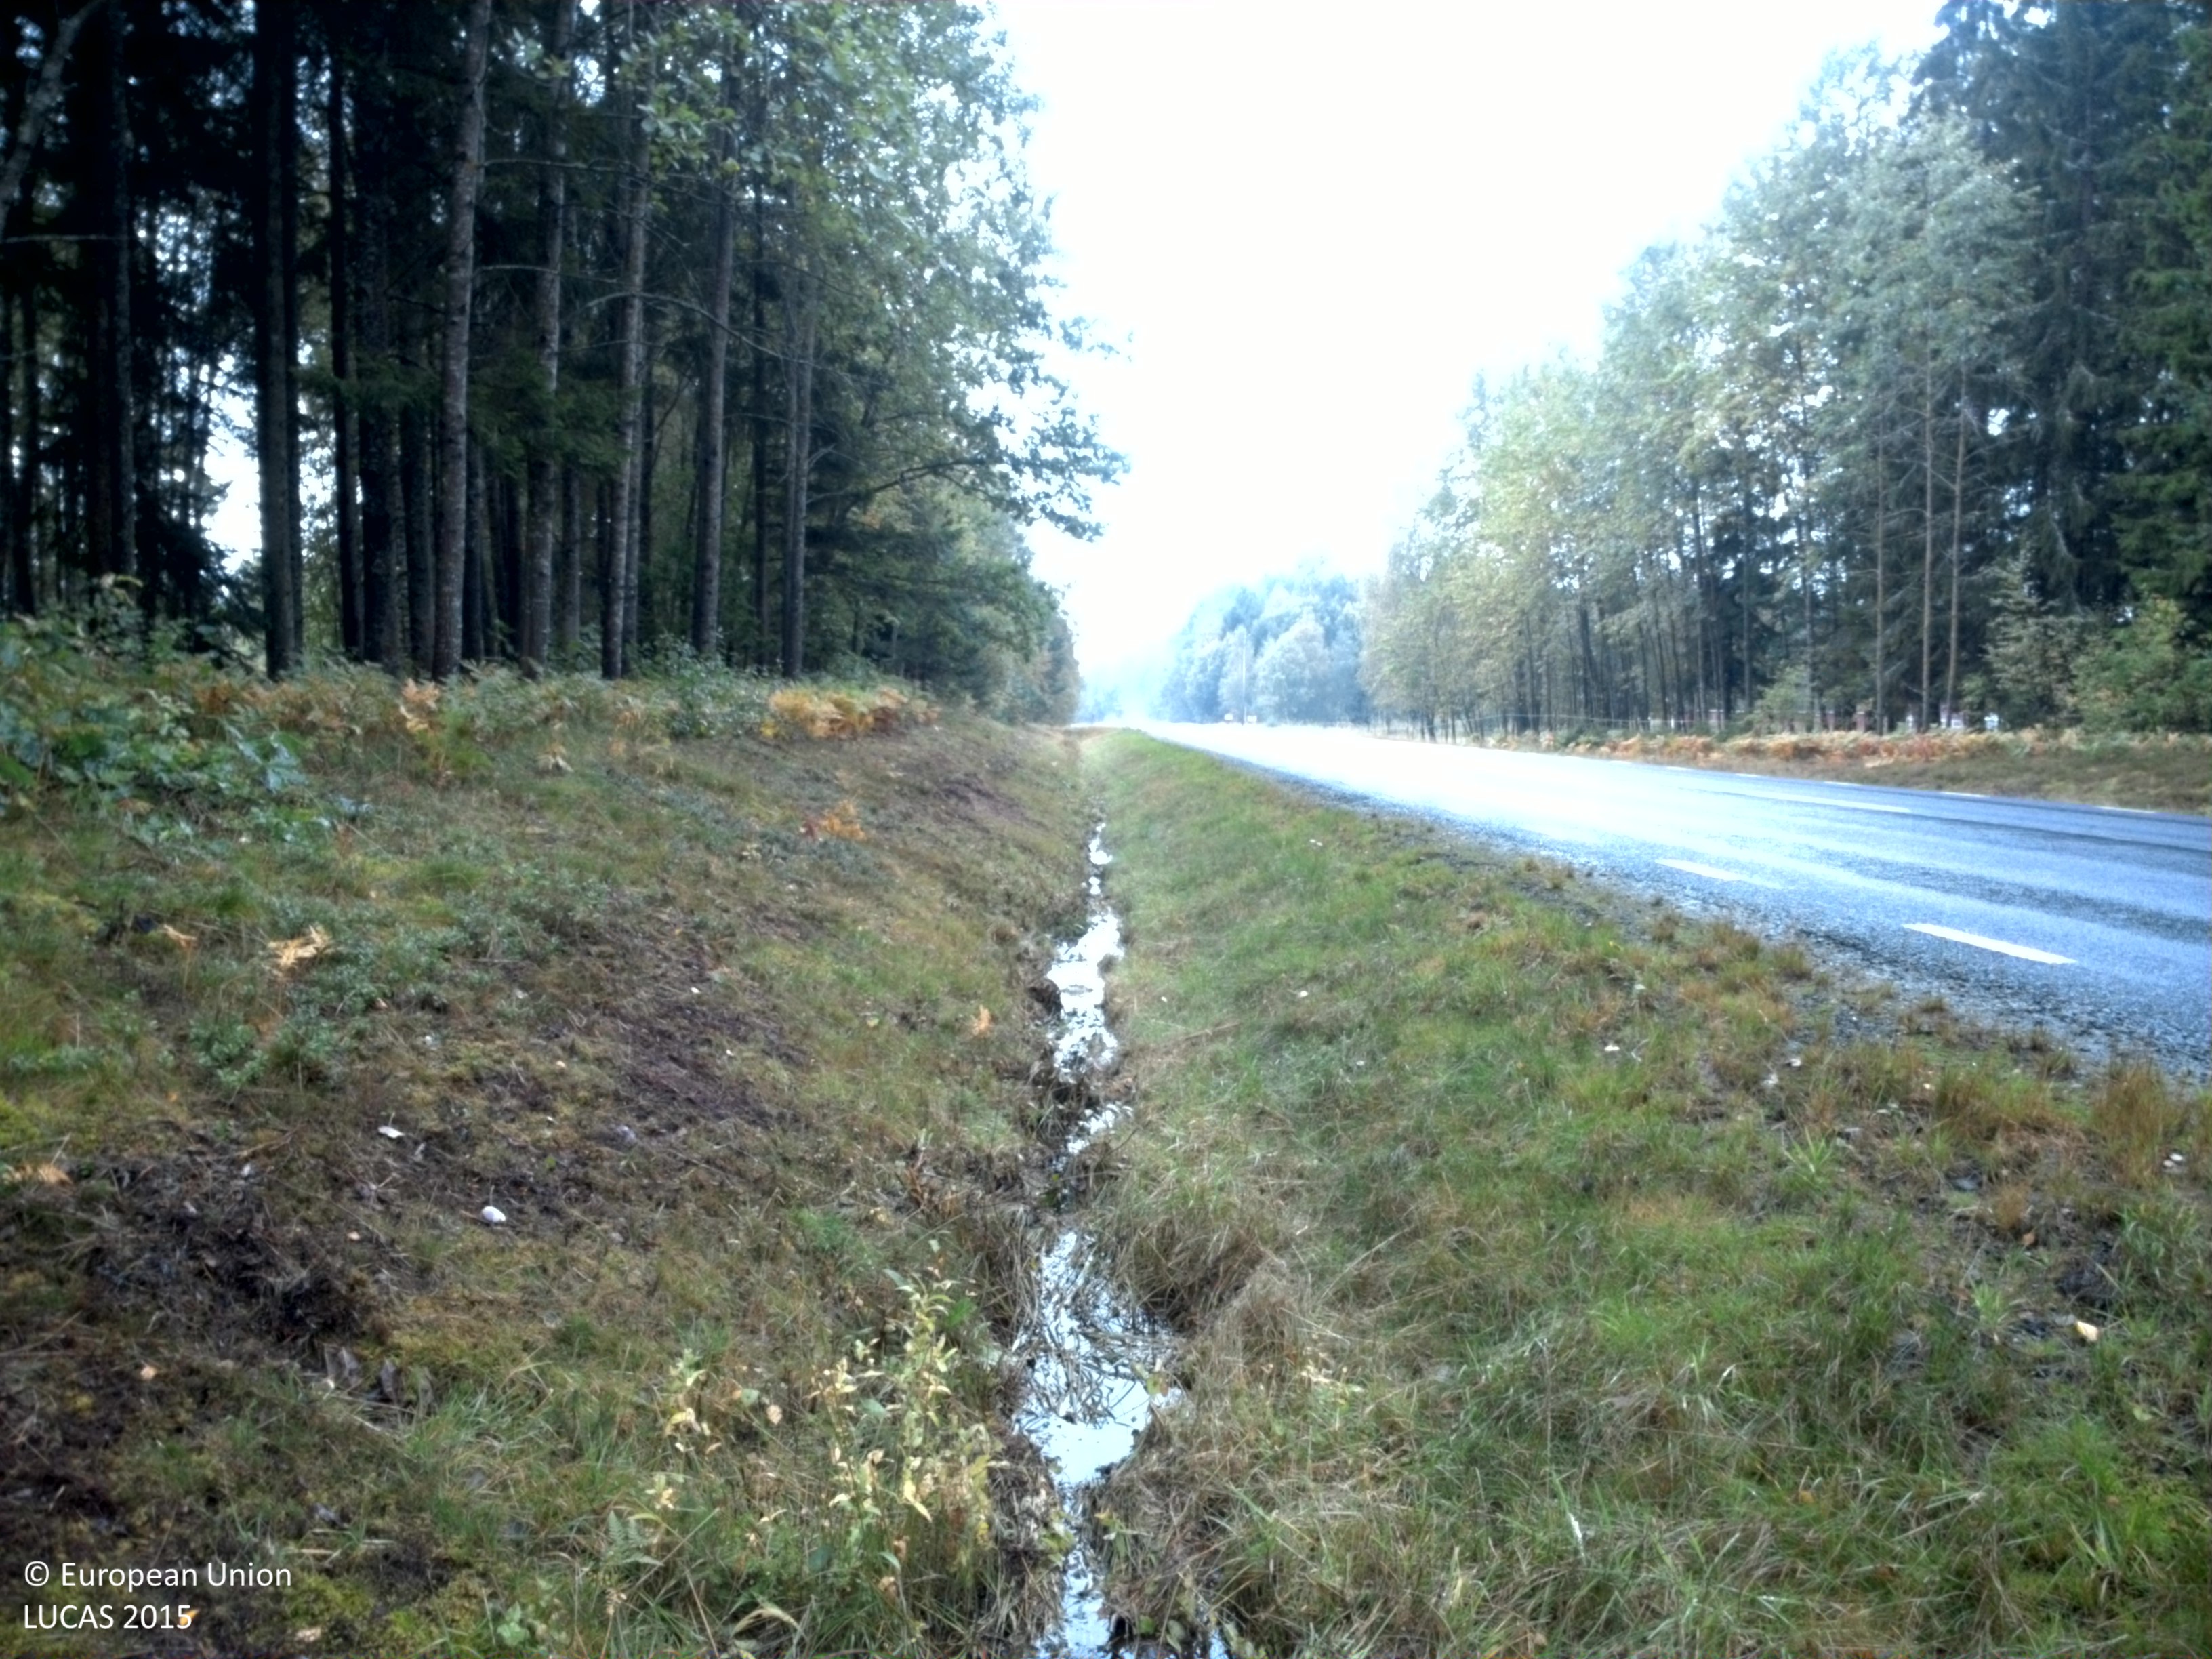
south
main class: Woodland
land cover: Spruce dominated mixed woodland
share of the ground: 50 - 75 %
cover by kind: coniferous forest trees 45 %, herbaceous plants 35 %, broadleaved forest trees 20 %
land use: Forestry
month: September
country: SE
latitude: 58.9503
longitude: 14.0774
